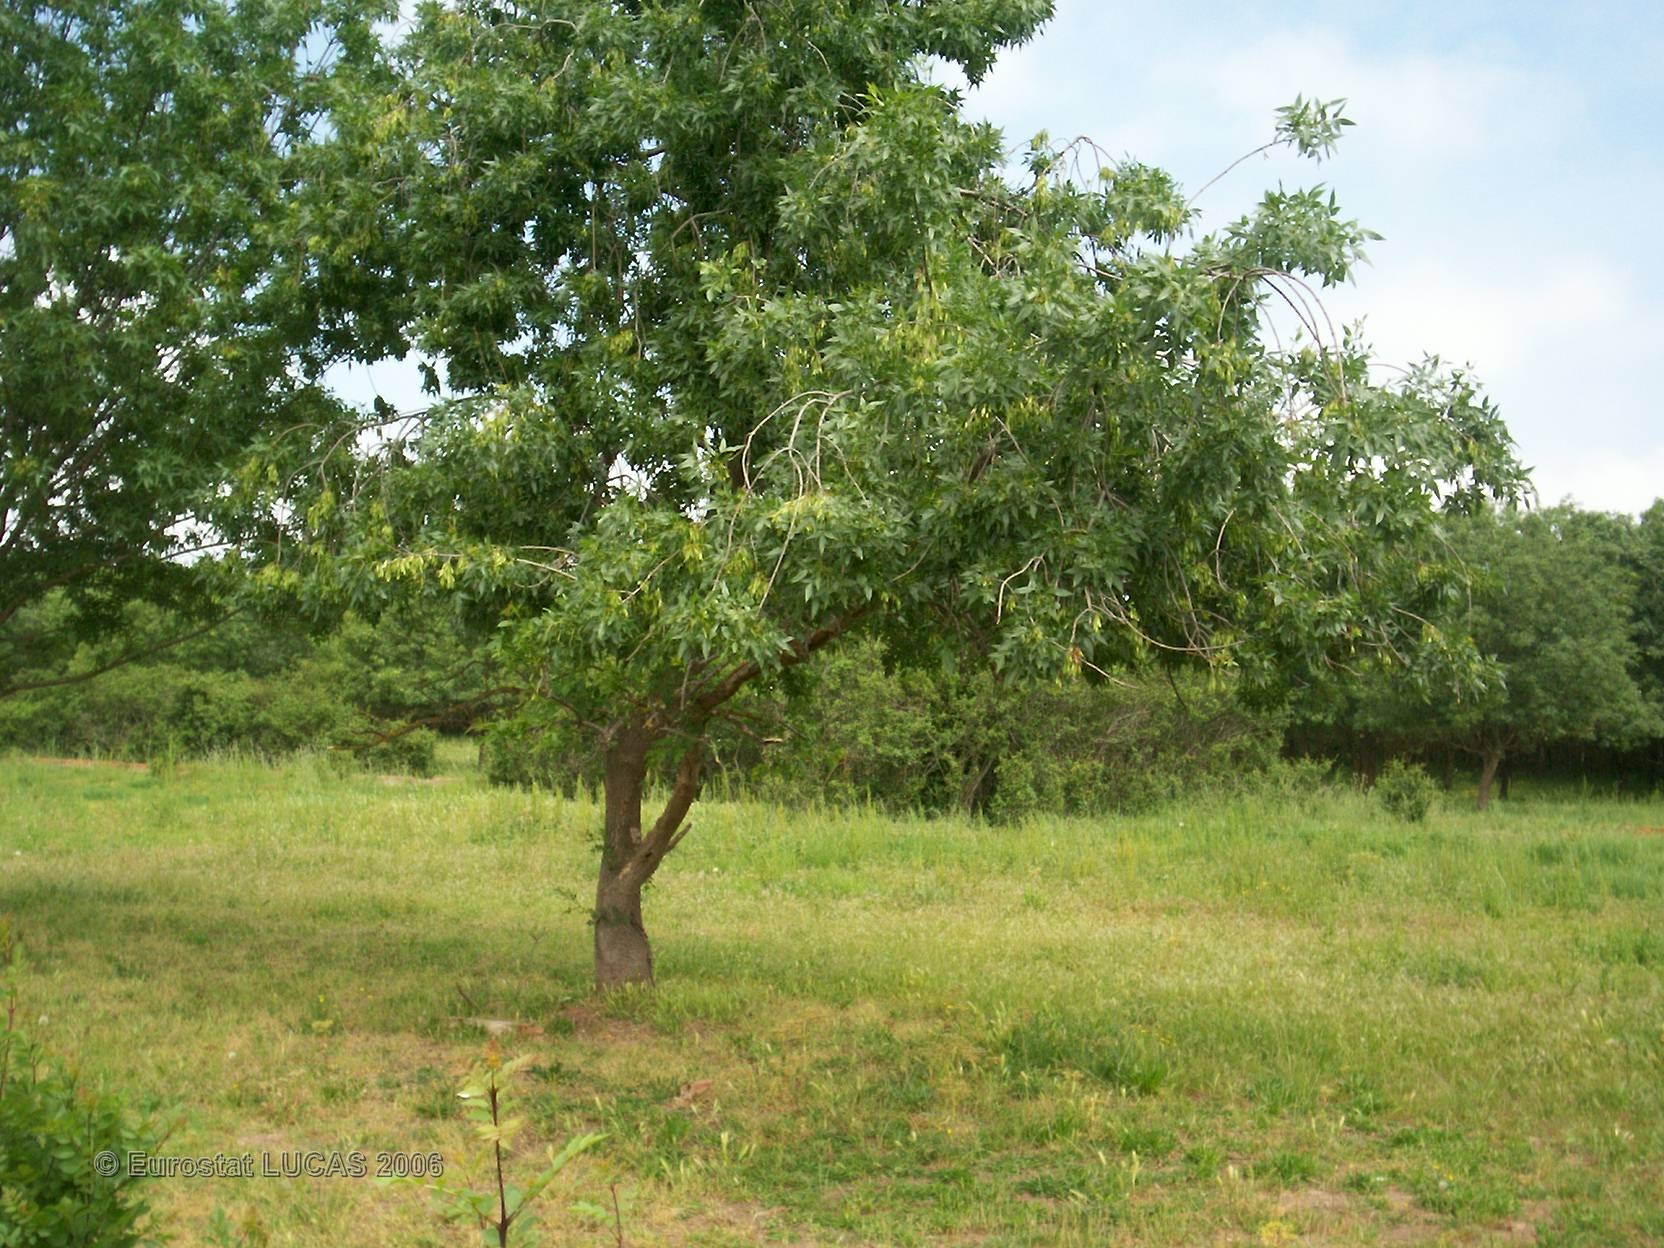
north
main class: Grassland
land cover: Grassland with sparse tree/shrub cover
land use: Agriculture (excluding fallow land and kitchen gardens)
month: May
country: FR
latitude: 43.3119
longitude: 3.4631
